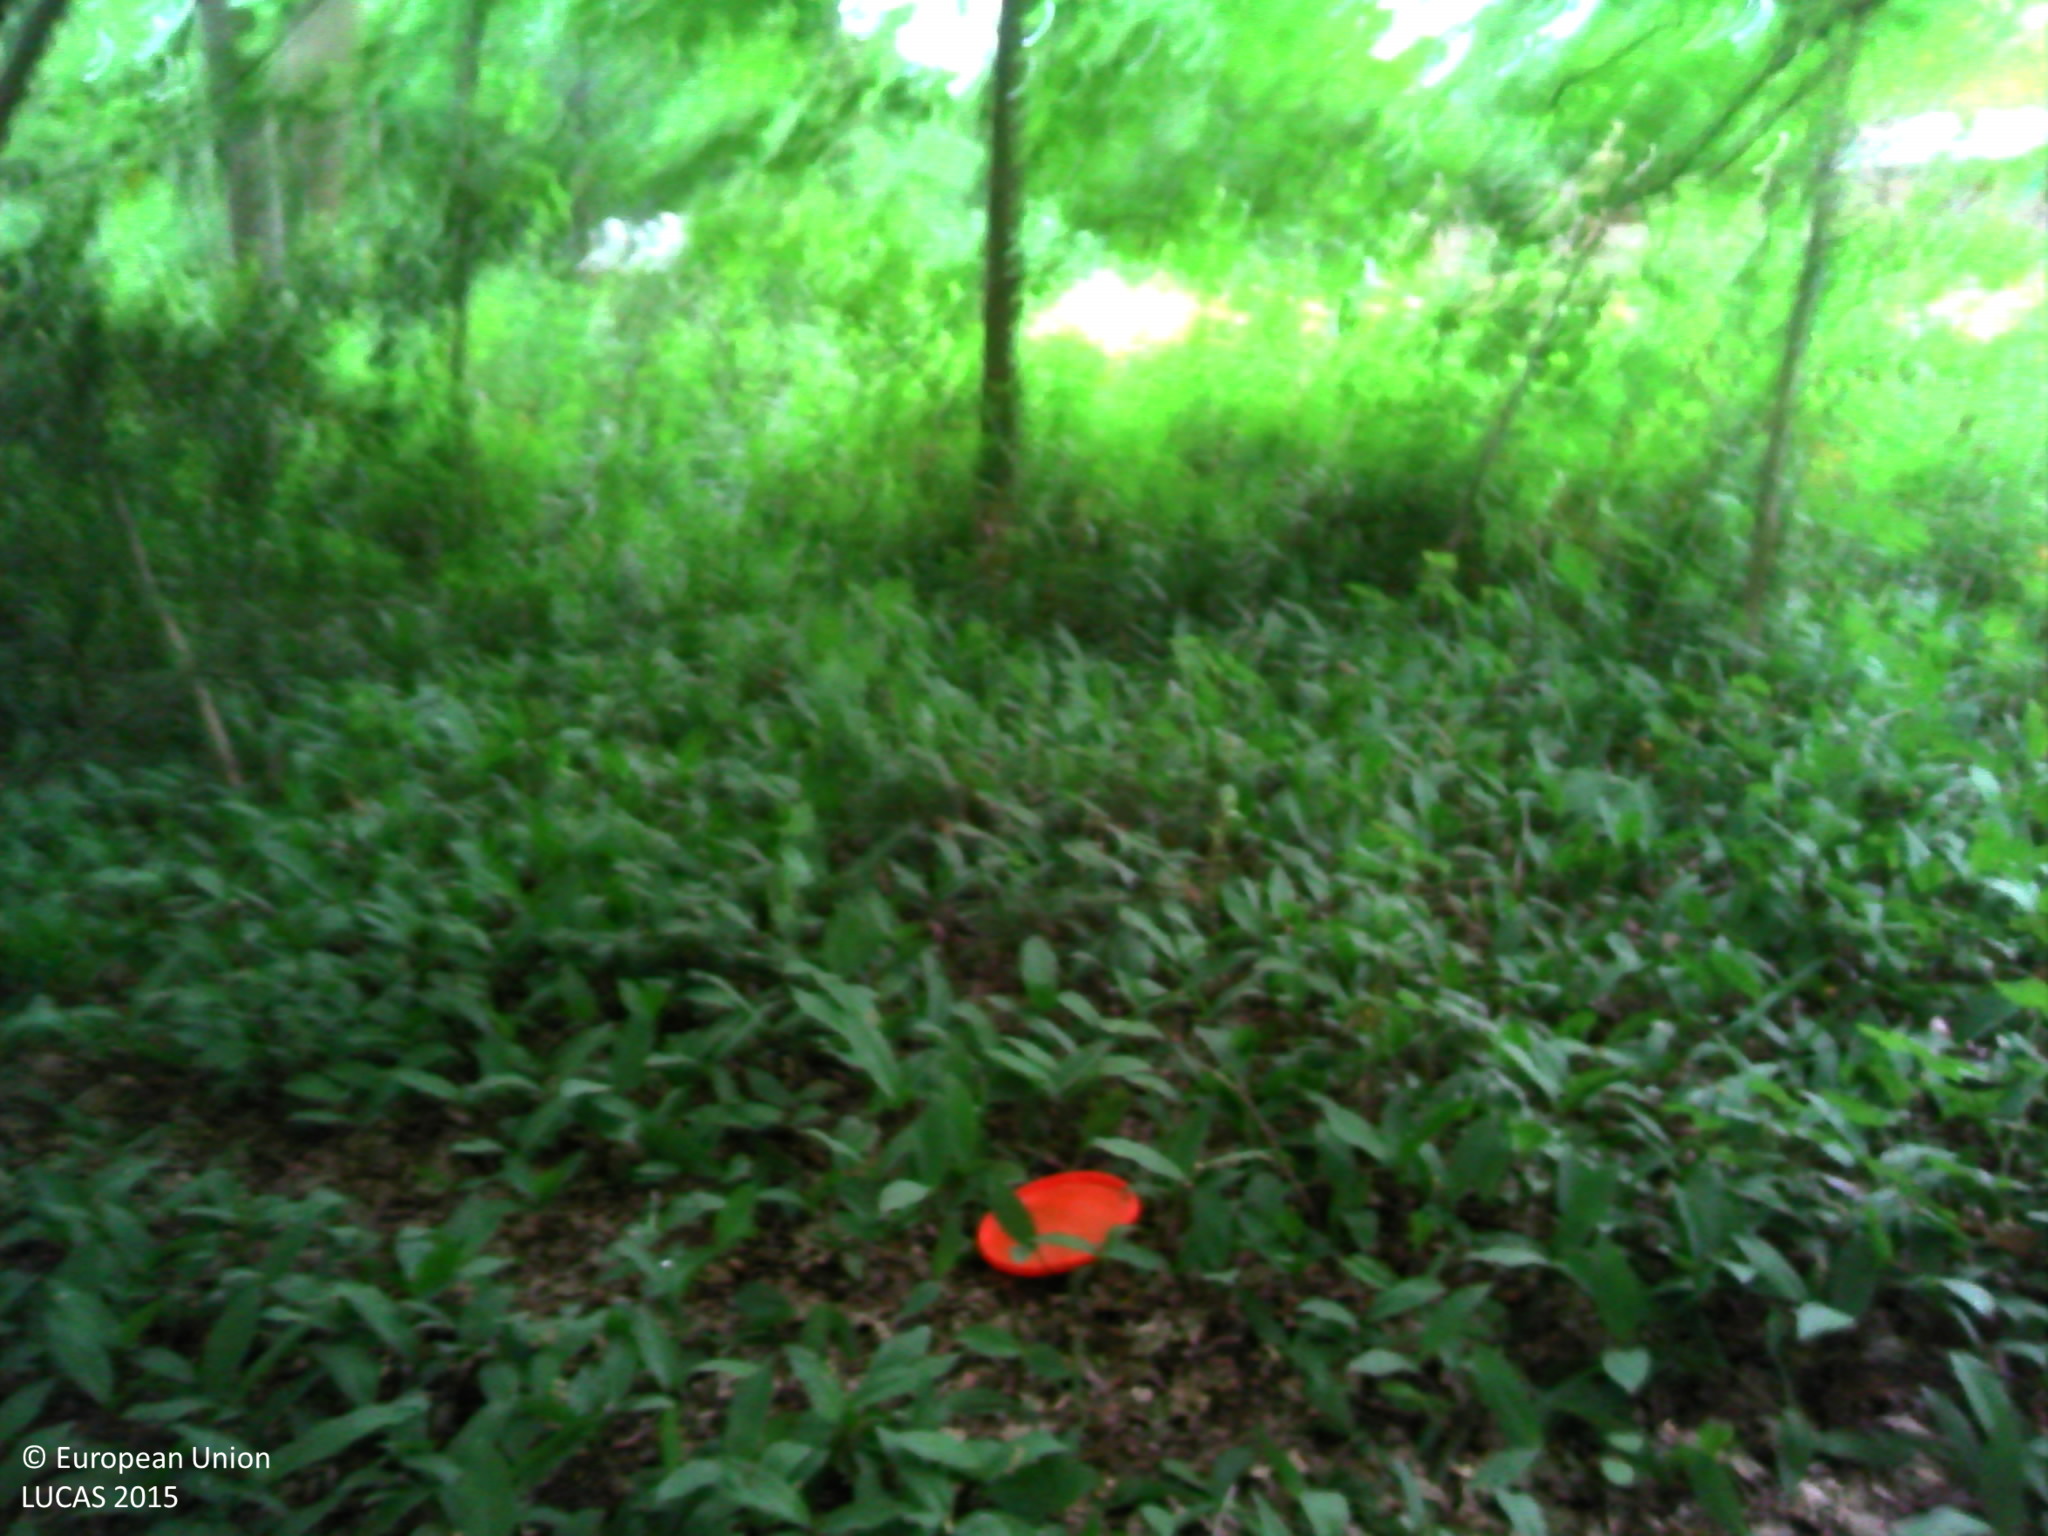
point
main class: Woodland
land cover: Broadleaved woodland
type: mesophytic deciduous forest
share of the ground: > 75 %
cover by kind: broadleaved forest trees 100 %
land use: Forestry
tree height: > 5 m
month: May
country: BE
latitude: 50.7038
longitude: 4.5729
